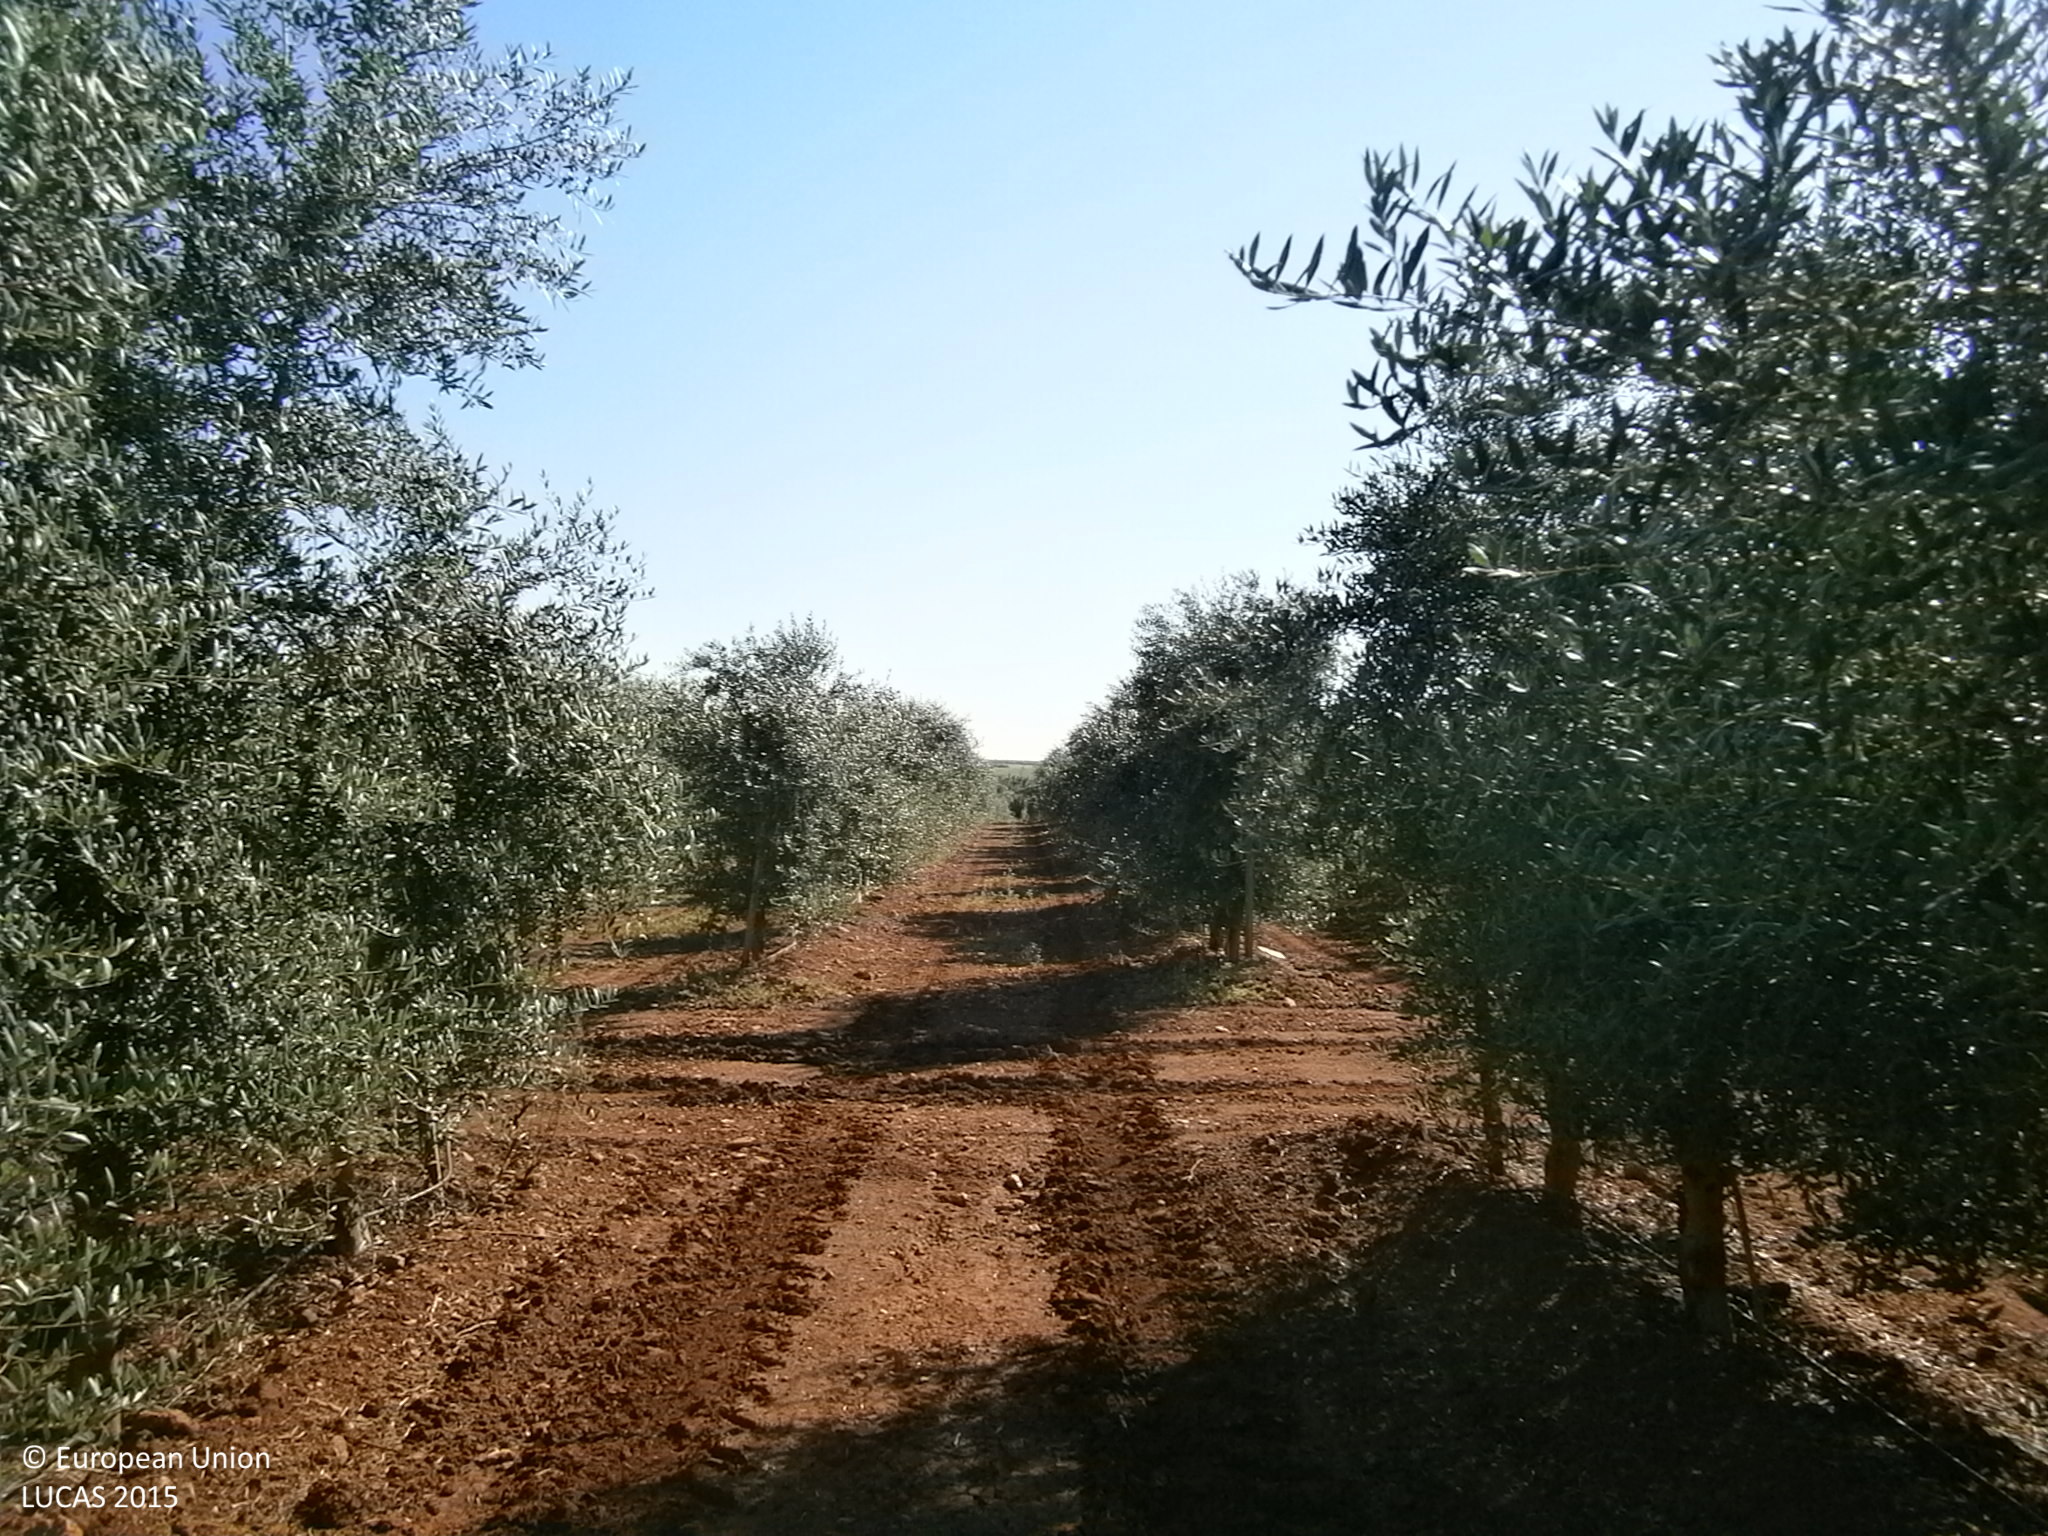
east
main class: Cropland
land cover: Olive groves
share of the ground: 25 - 50 %
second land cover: Other bare soil
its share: > 75 %
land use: Agriculture (excluding fallow land and kitchen gardens)
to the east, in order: Olive groves; Other bare soil; Tracks; Olive groves
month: June
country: ES
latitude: 38.6861
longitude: -6.6484
